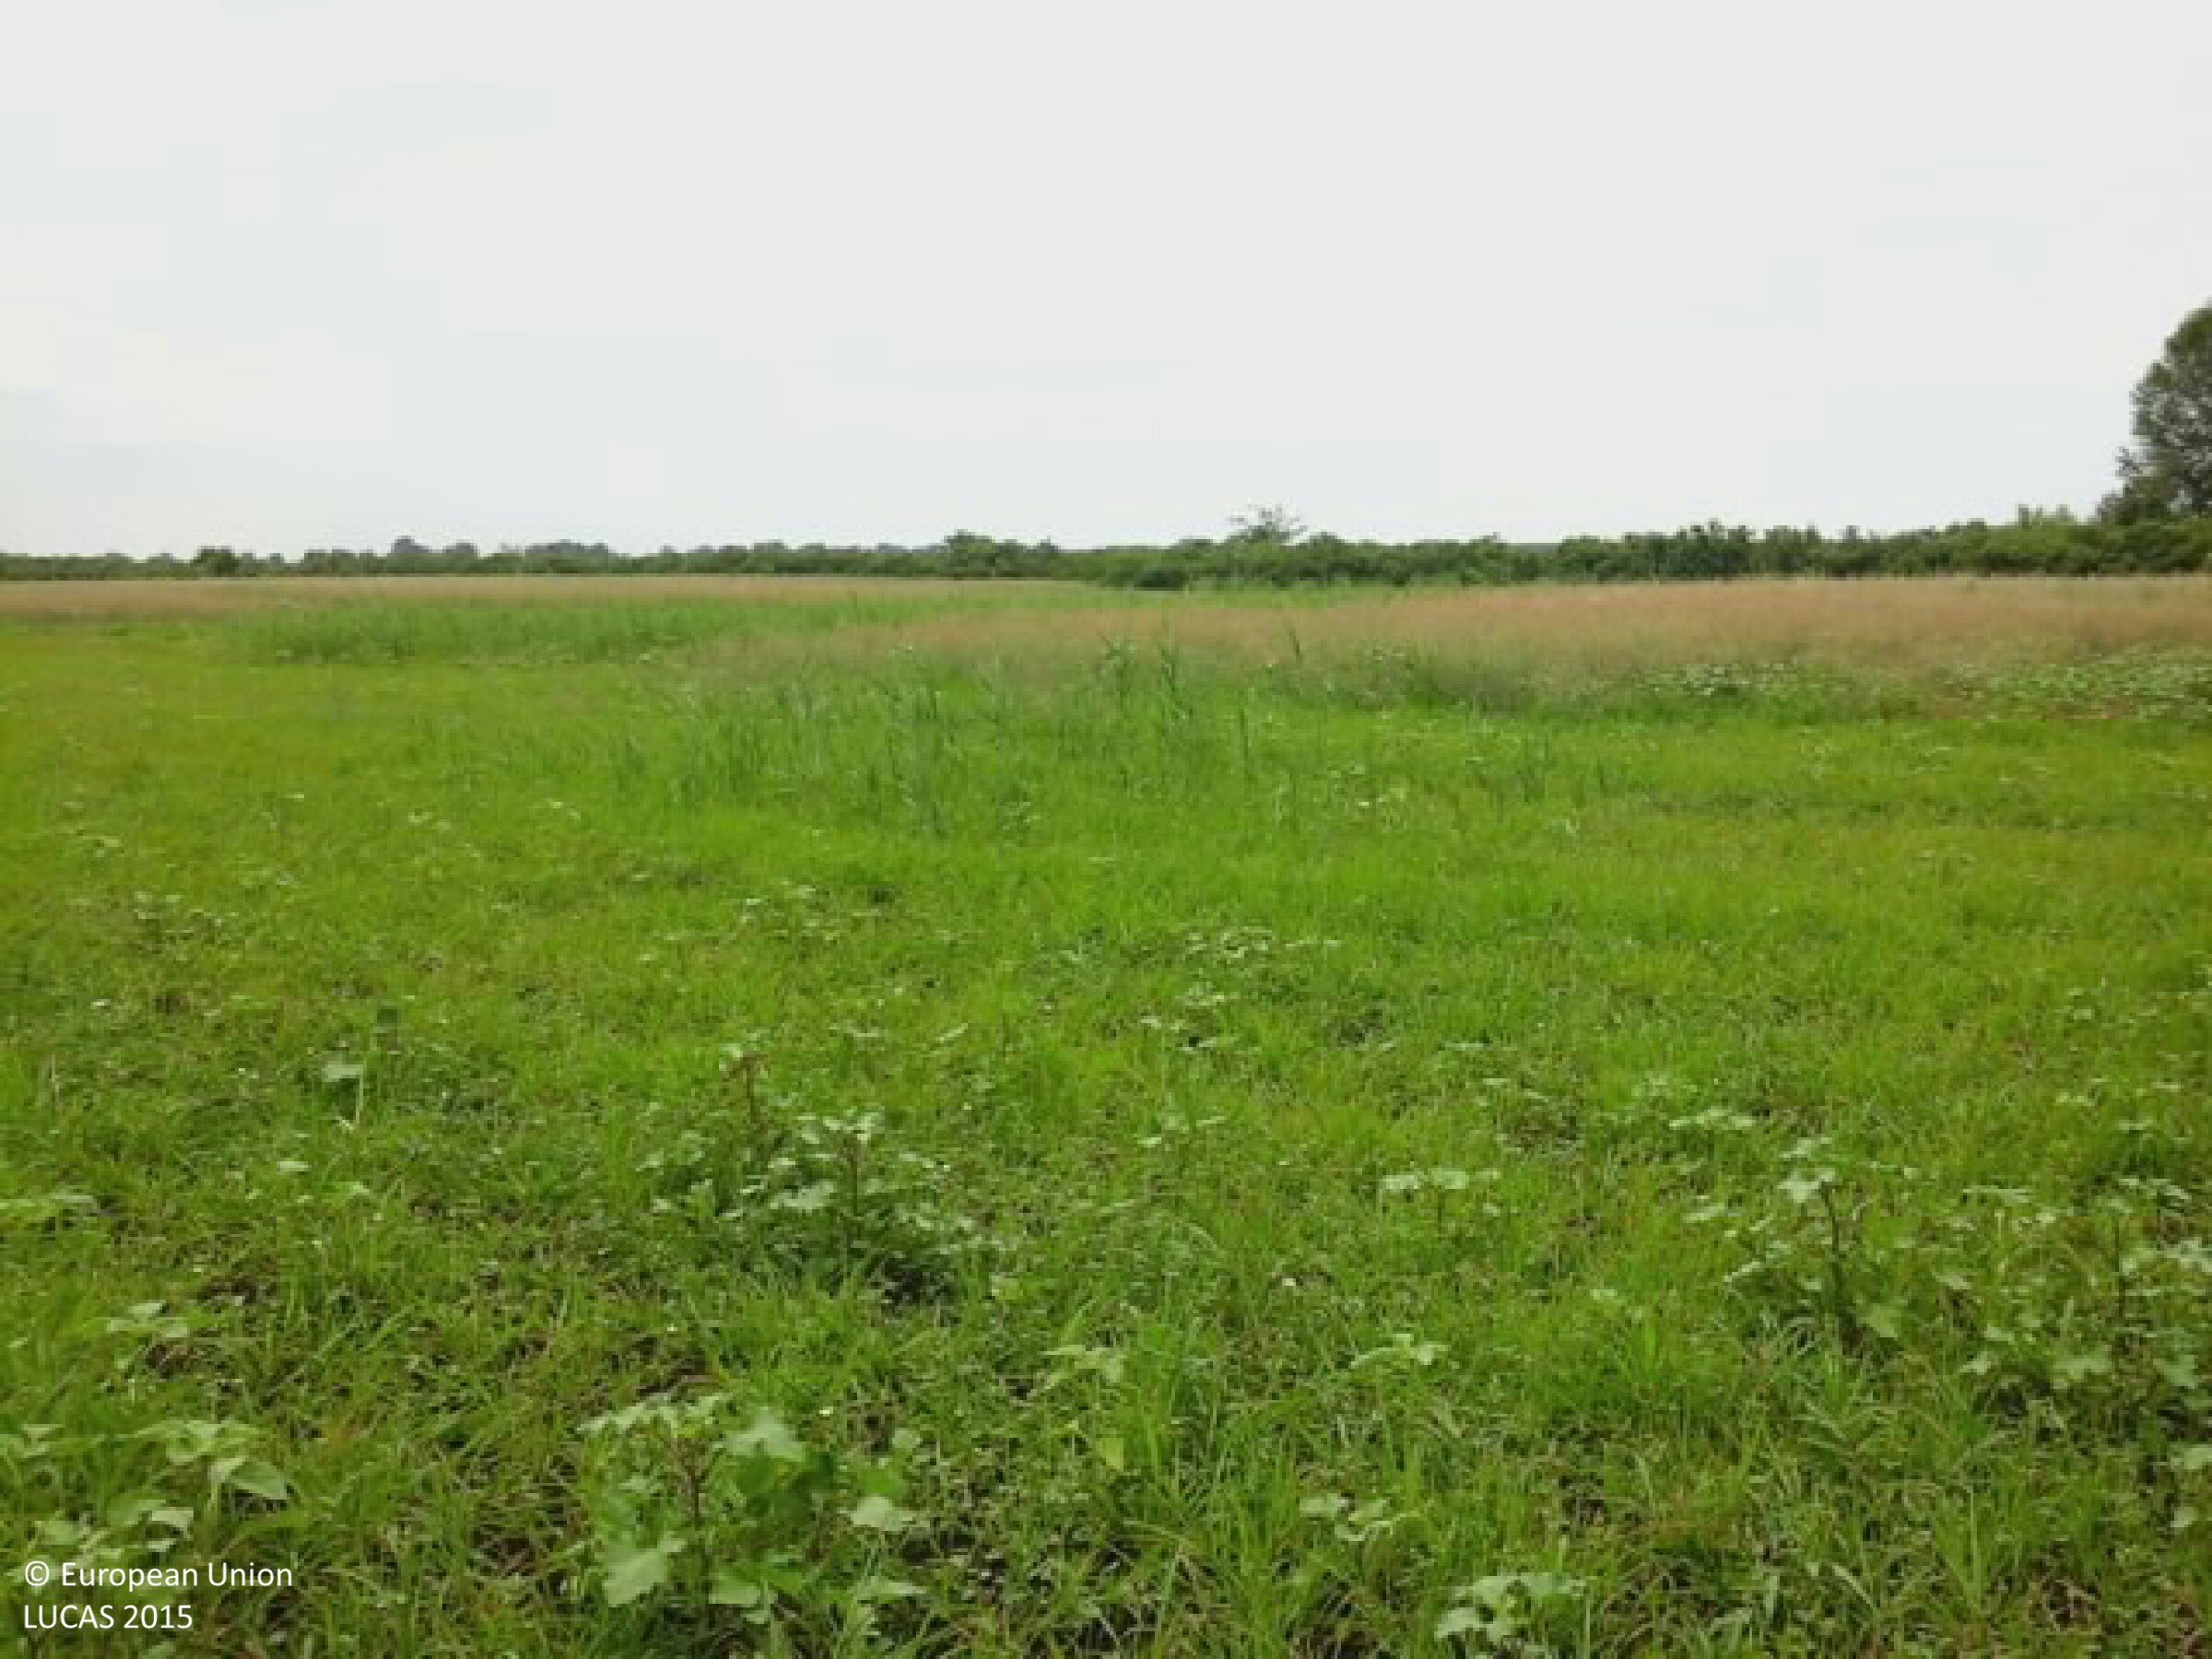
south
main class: Grassland
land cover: Spontaneously vegetated surfaces
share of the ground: > 75 %
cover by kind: herbaceous plants 100 %
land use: Fallow land
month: June
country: HU
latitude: 46.5584
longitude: 20.1325
